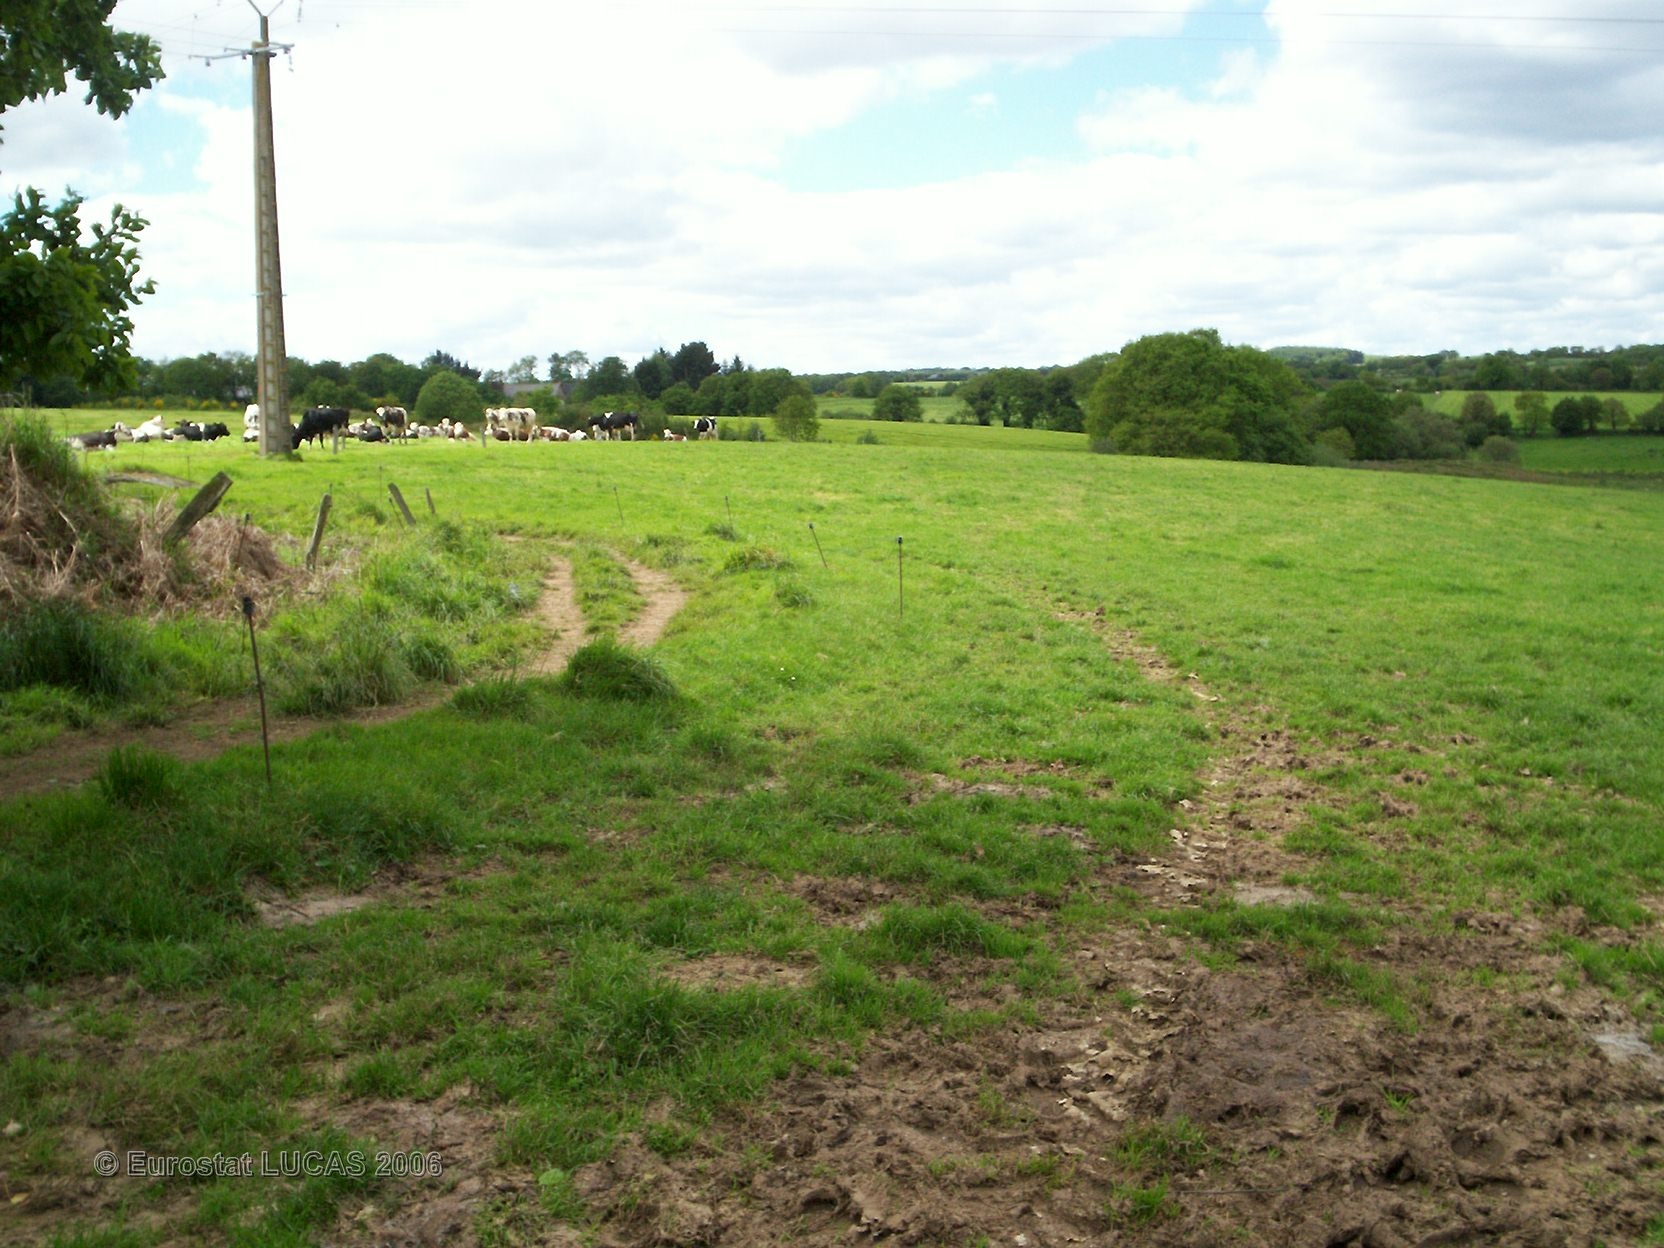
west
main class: Grassland
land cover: Grassland without tree/shrub cover
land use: Agriculture (excluding fallow land and kitchen gardens)
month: May
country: FR
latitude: 48.4011
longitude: -2.9687
